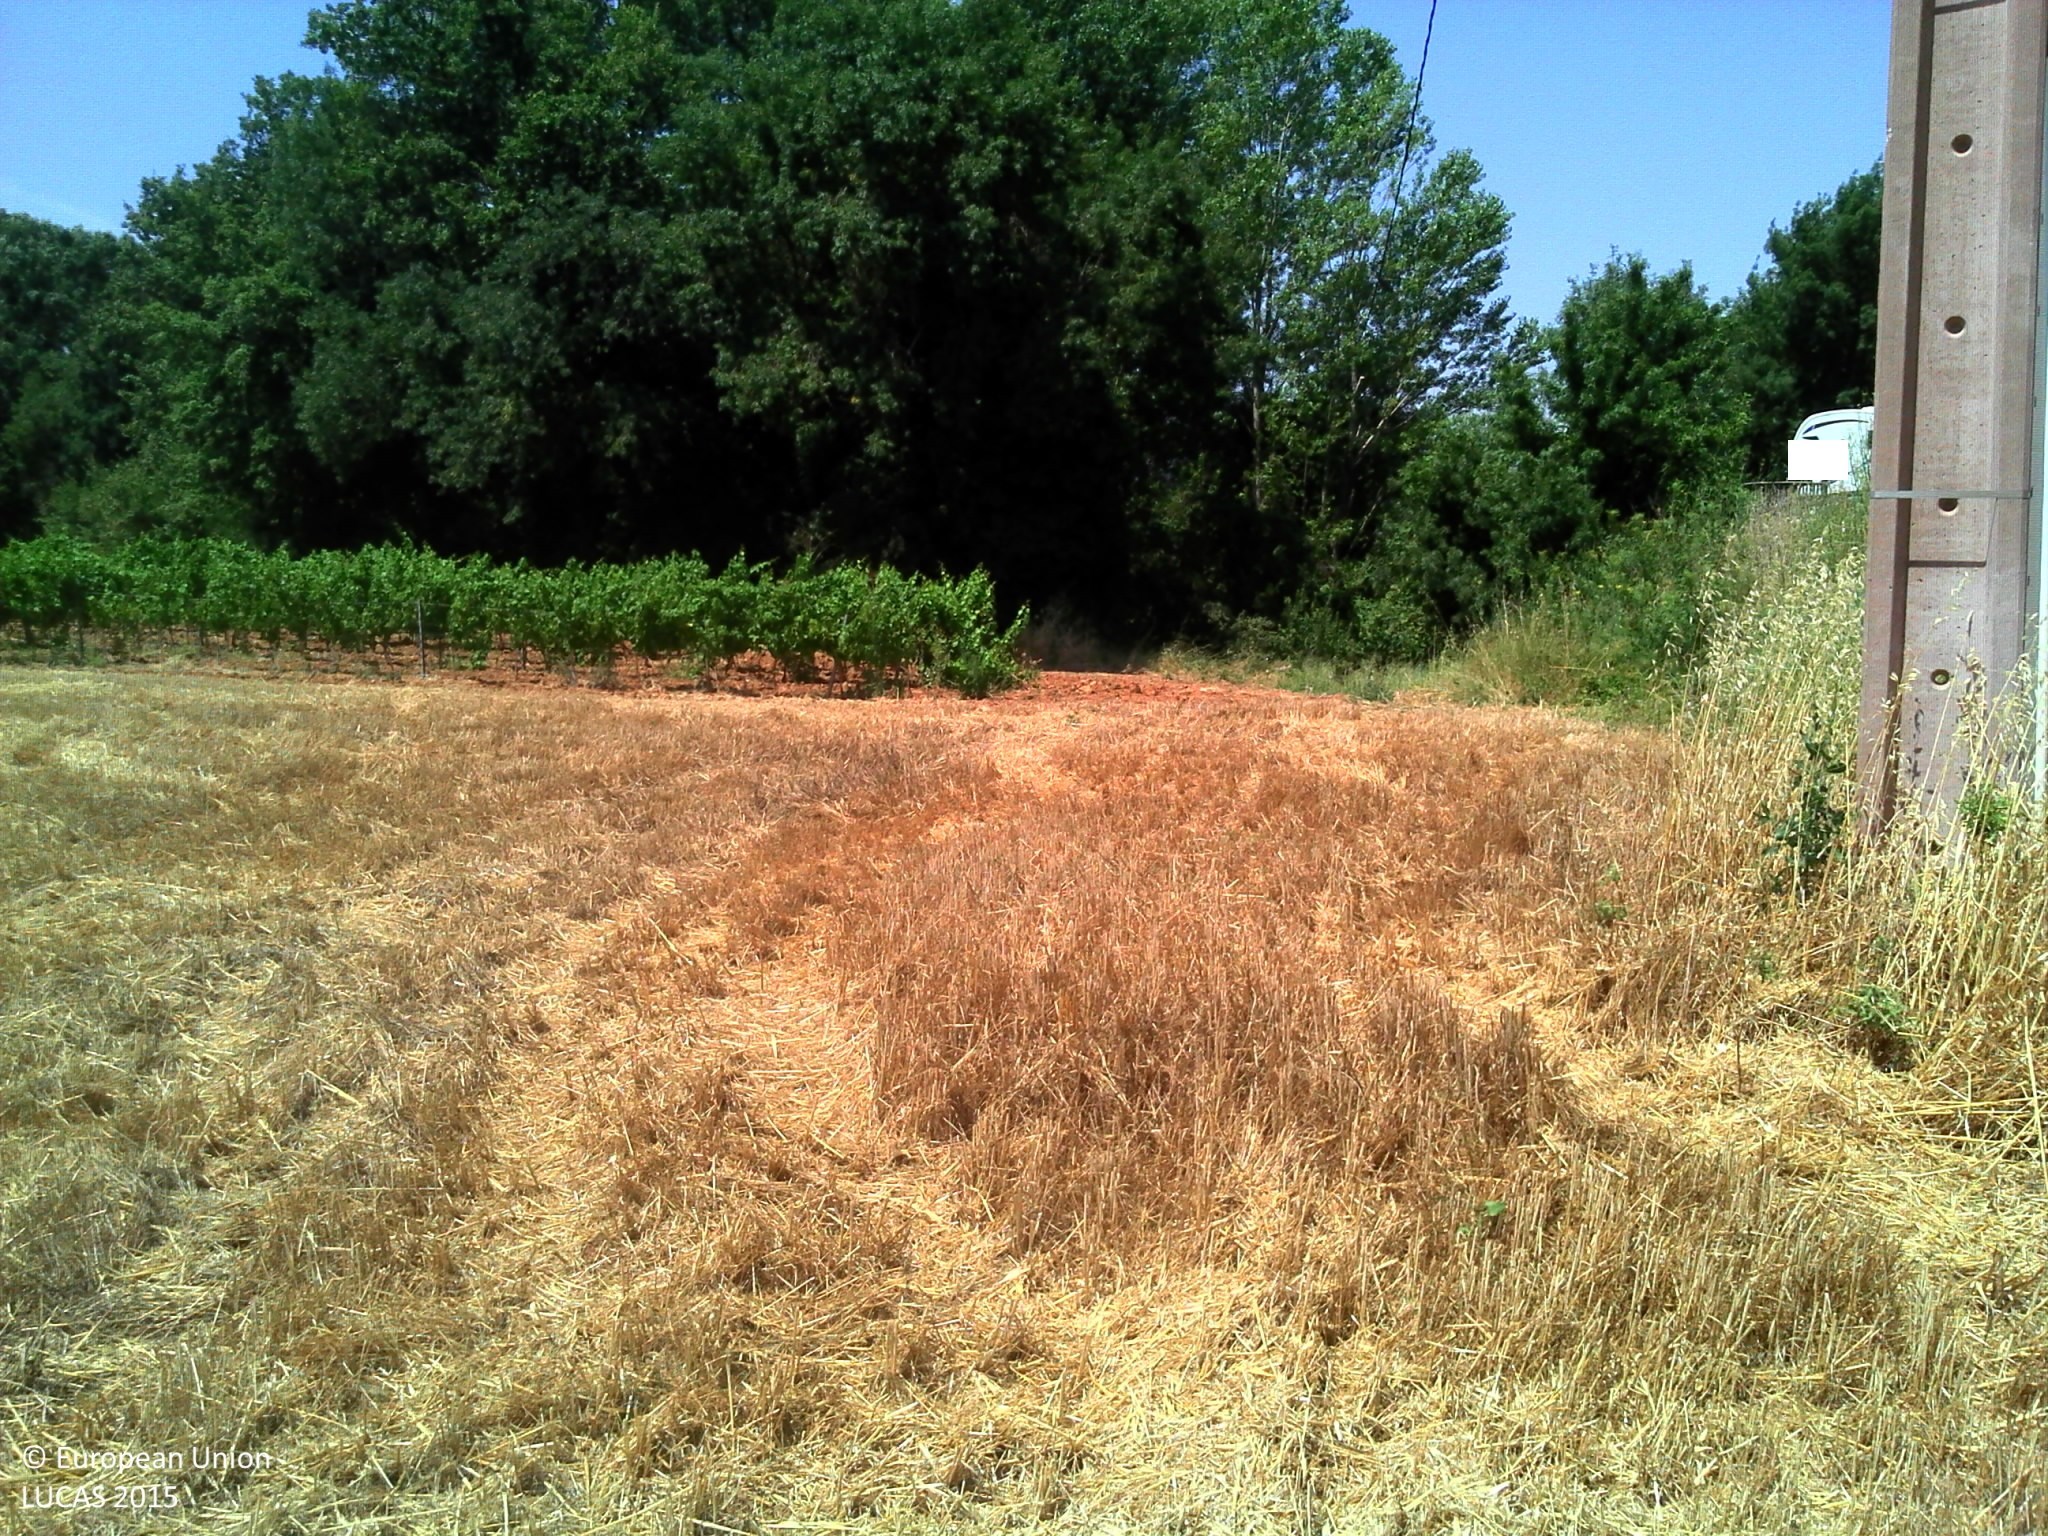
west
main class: Cropland
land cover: Common wheat
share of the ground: > 75 %
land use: Agriculture (excluding fallow land and kitchen gardens)
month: July
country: FR
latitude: 43.4855
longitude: 5.7191
